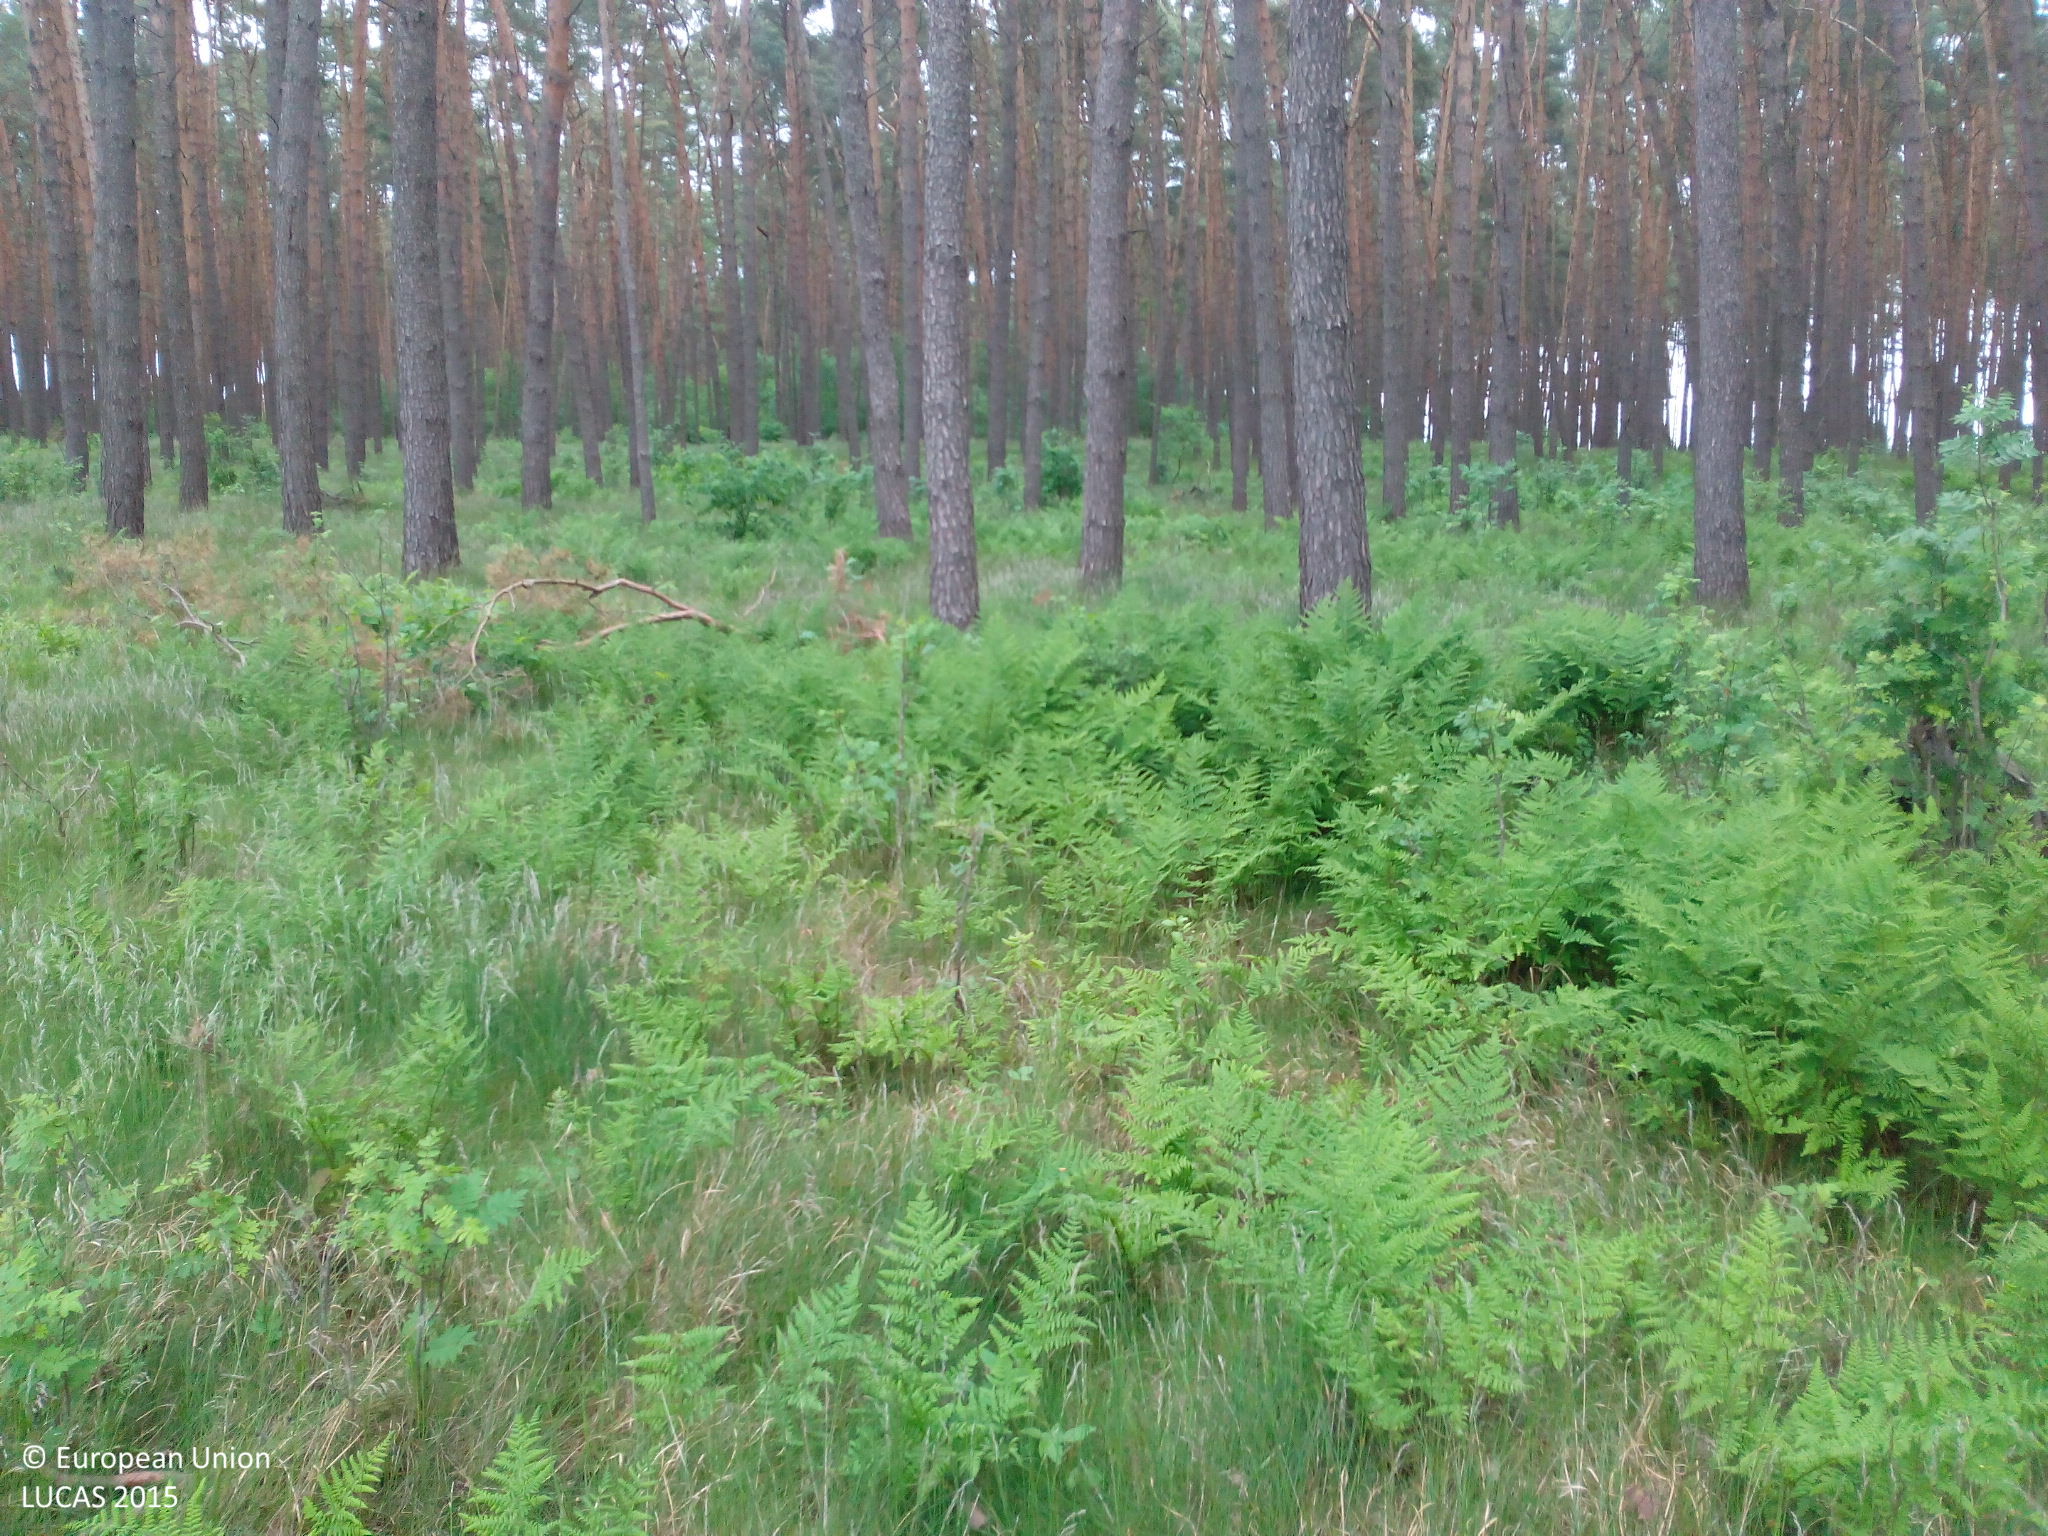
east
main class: Woodland
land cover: Pine dominated coniferous woodland
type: hemiboreal forest and nemoral coniferous forest and mixed broadleaved-coniferous forest
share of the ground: > 75 %
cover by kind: coniferous forest trees 85 %, herbaceous plants 10 %, shrubs 5 %
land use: Forestry
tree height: > 5 m
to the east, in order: Pine dominated coniferous woodland
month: June
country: DE
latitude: 53.3010
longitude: 11.6349
